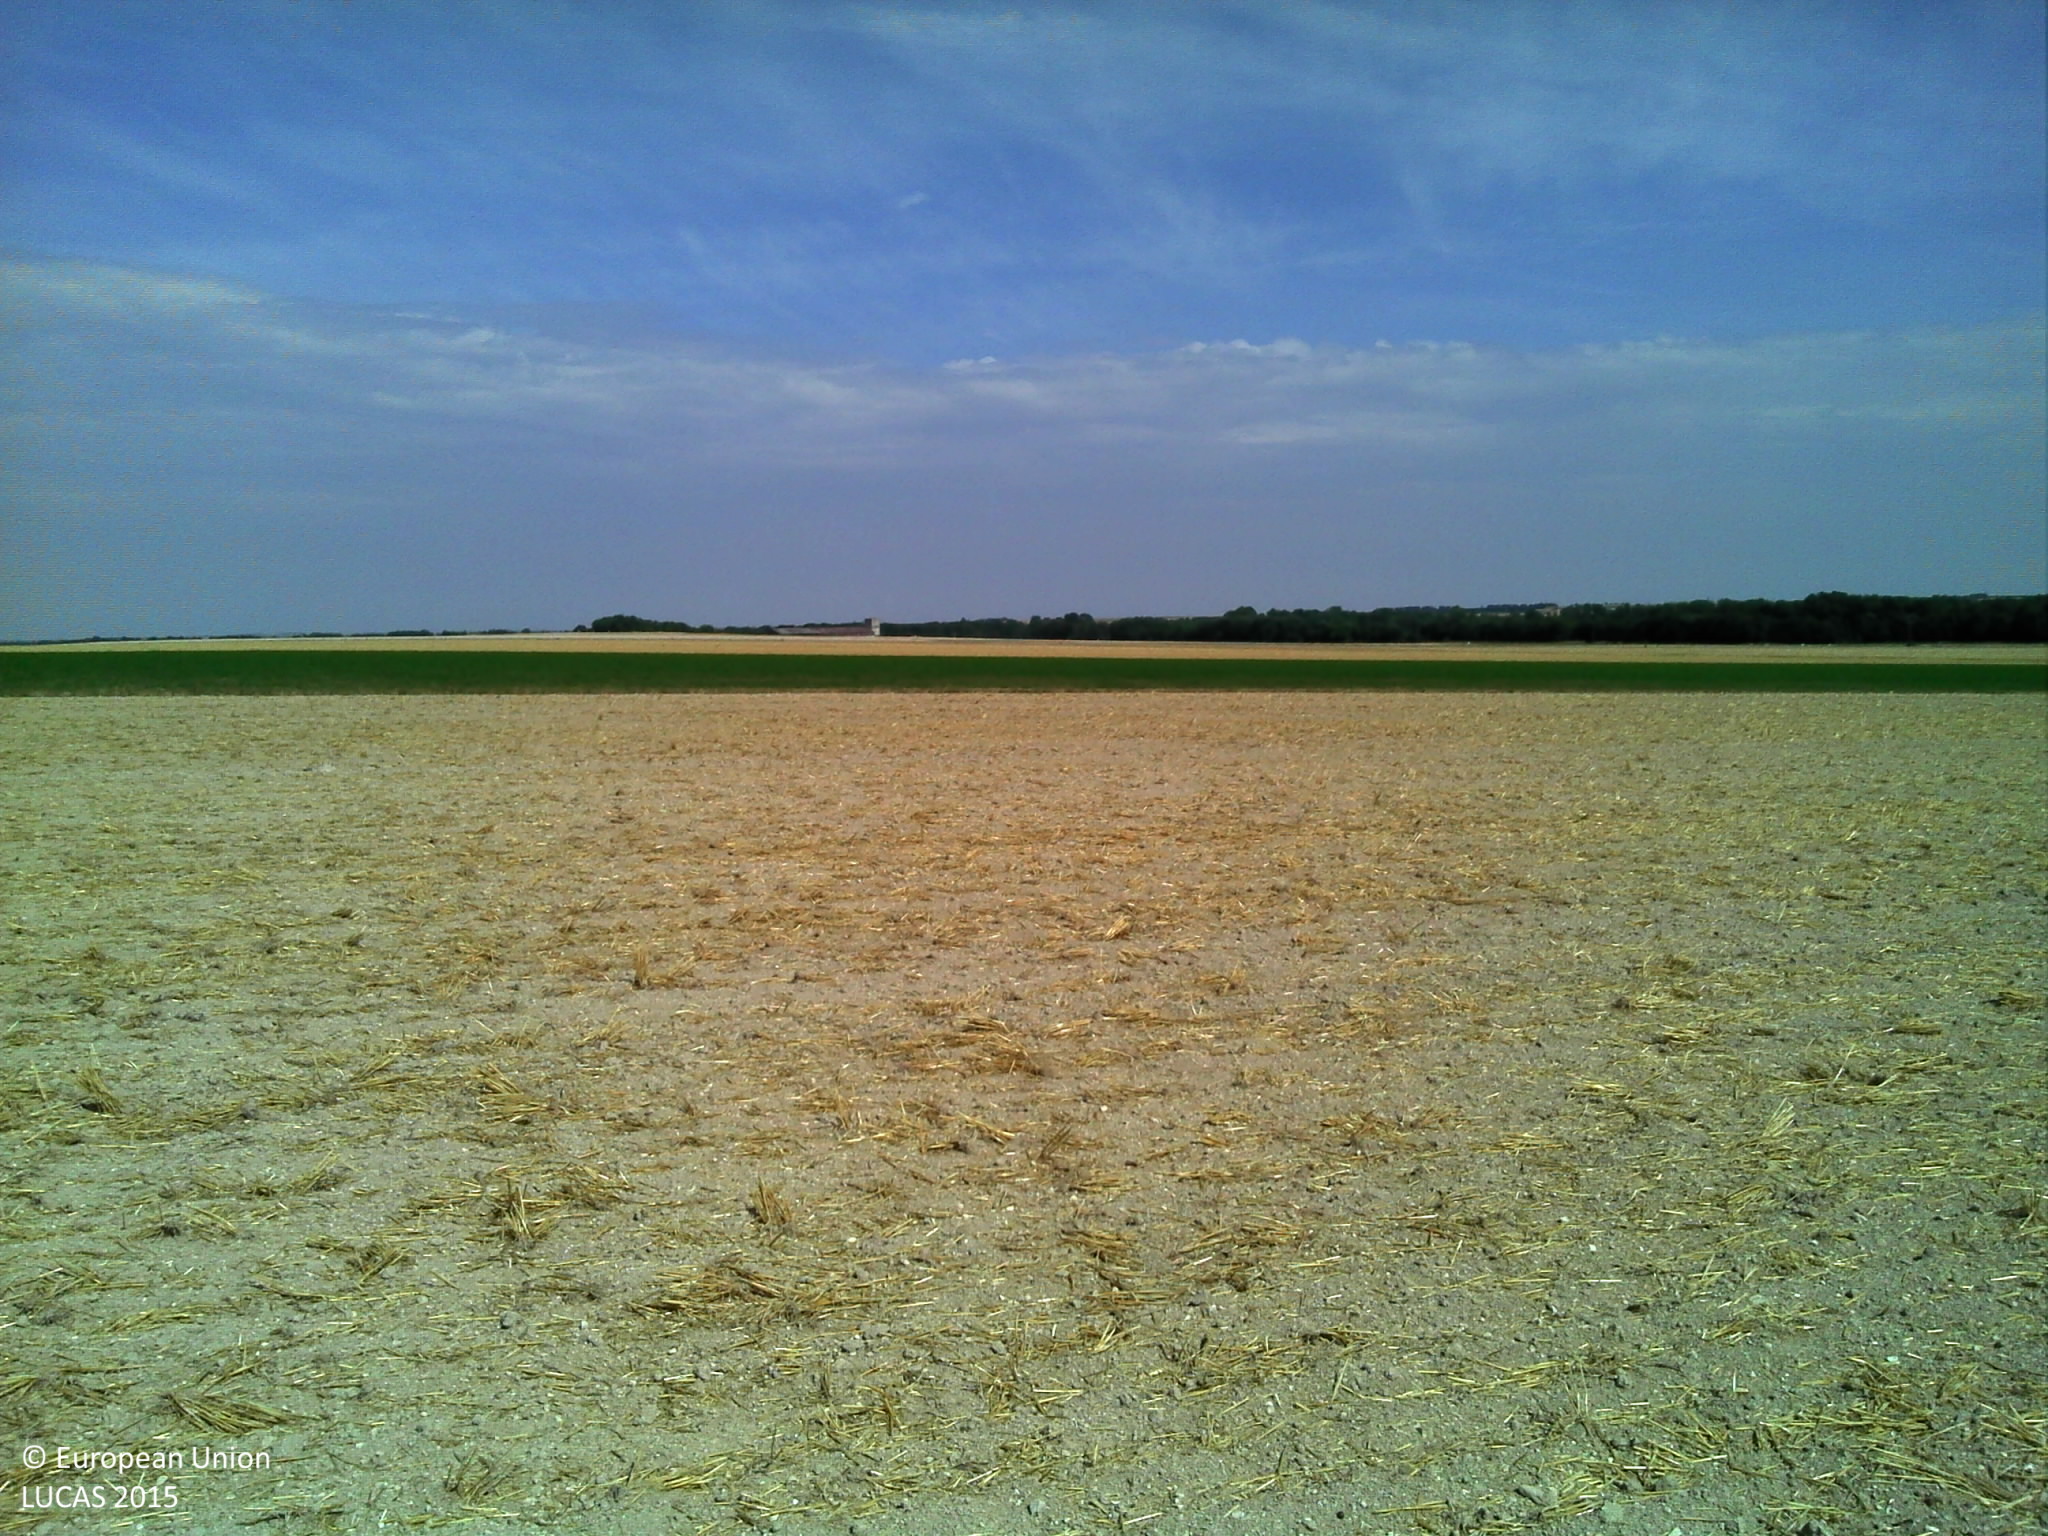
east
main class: Cropland
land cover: Common wheat
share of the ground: > 75 %
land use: Agriculture (excluding fallow land and kitchen gardens)
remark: Tilled/Sowed
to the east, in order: Common wheat; Grass margins; Tracks; Grass margins; Sugar beet; Lucerne
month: August
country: FR
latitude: 48.9500
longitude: 4.1102
